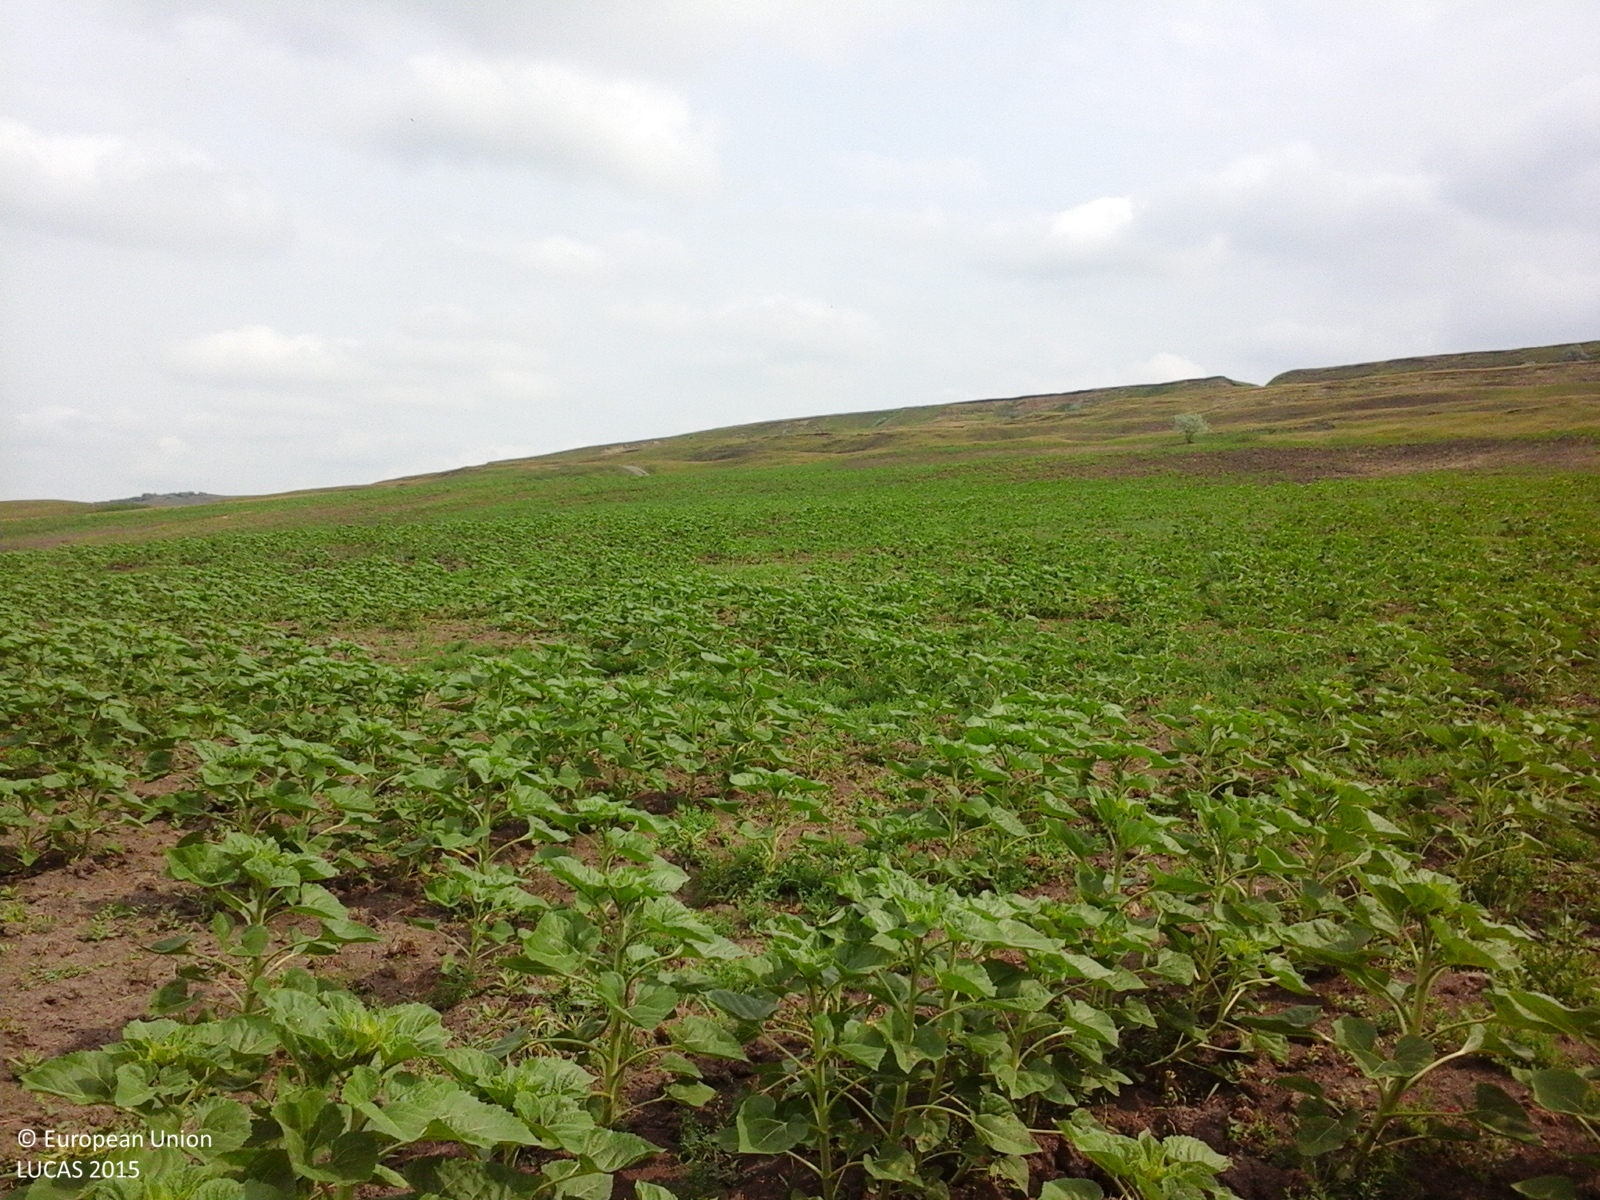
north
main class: Cropland
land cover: Sunflower
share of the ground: 25 - 50 %
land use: Agriculture (excluding fallow land and kitchen gardens)
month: June
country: RO
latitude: 47.9528
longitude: 26.5500
